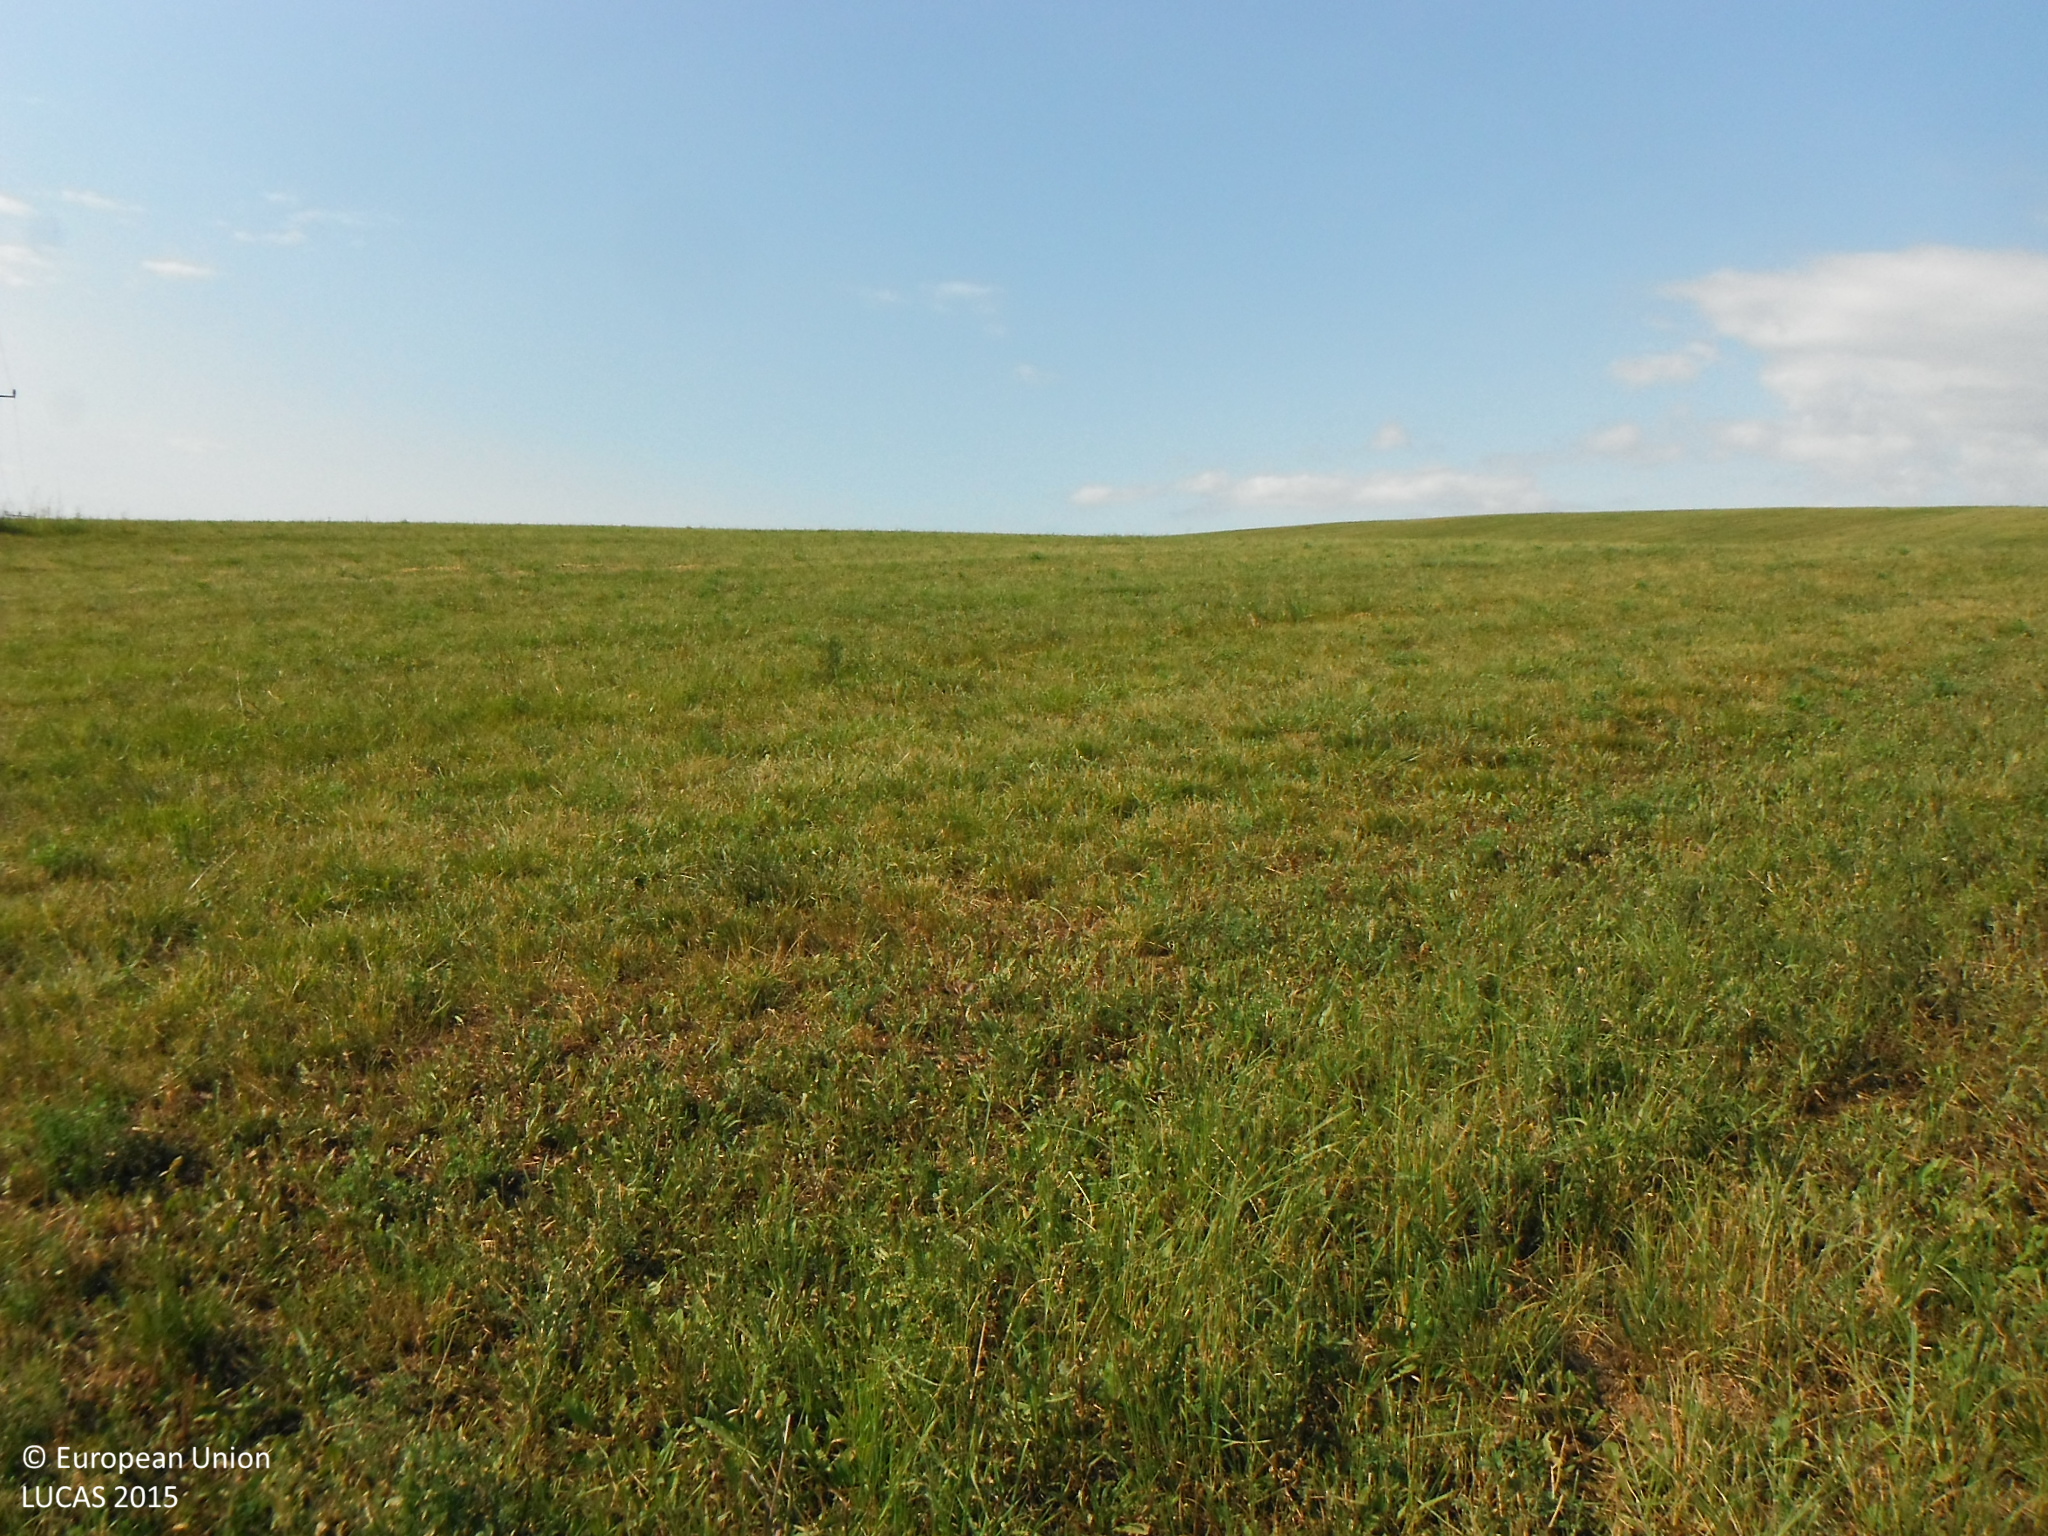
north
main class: Cropland
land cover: Other leguminous and mixtures for fodder
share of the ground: > 75 %
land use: Agriculture (excluding fallow land and kitchen gardens)
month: July
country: SK
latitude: 48.6357
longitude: 21.5143
